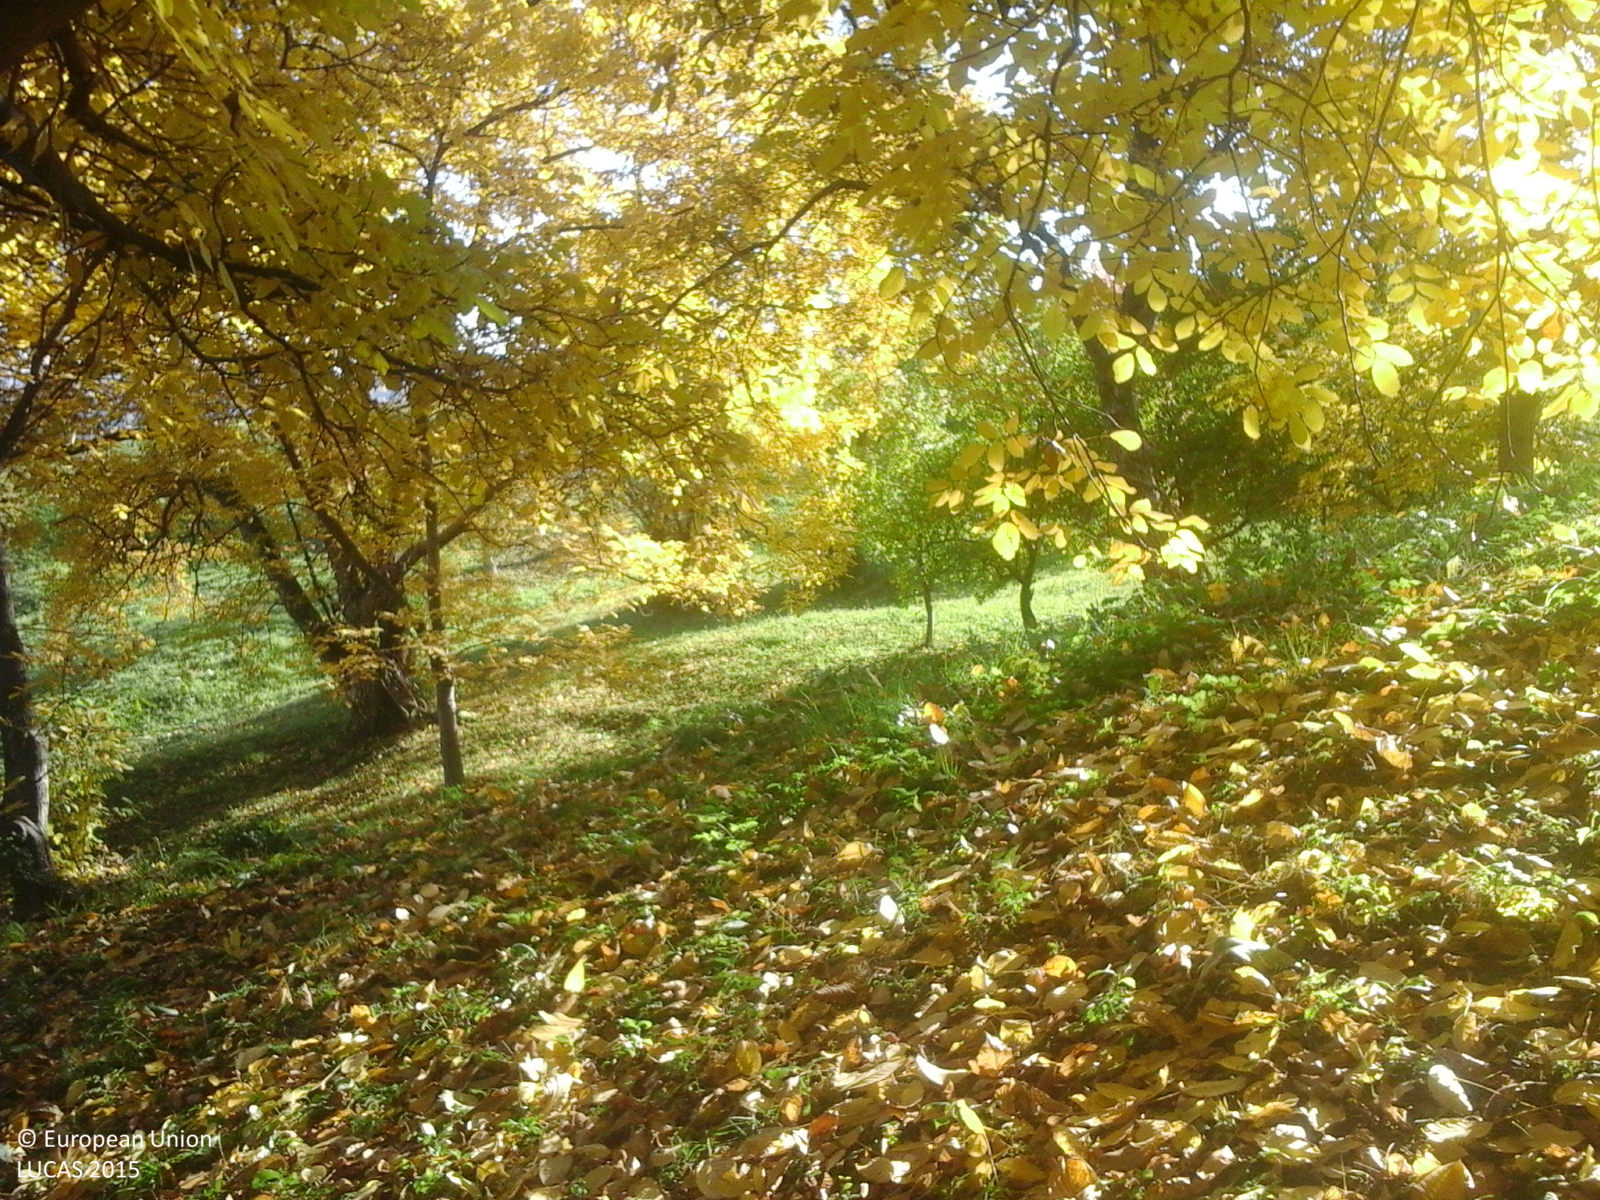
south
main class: Woodland
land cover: Broadleaved woodland
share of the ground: > 75 %
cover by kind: broadleaved forest trees 100 %
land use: Forestry
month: October
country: RO
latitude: 45.8601
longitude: 26.6580
